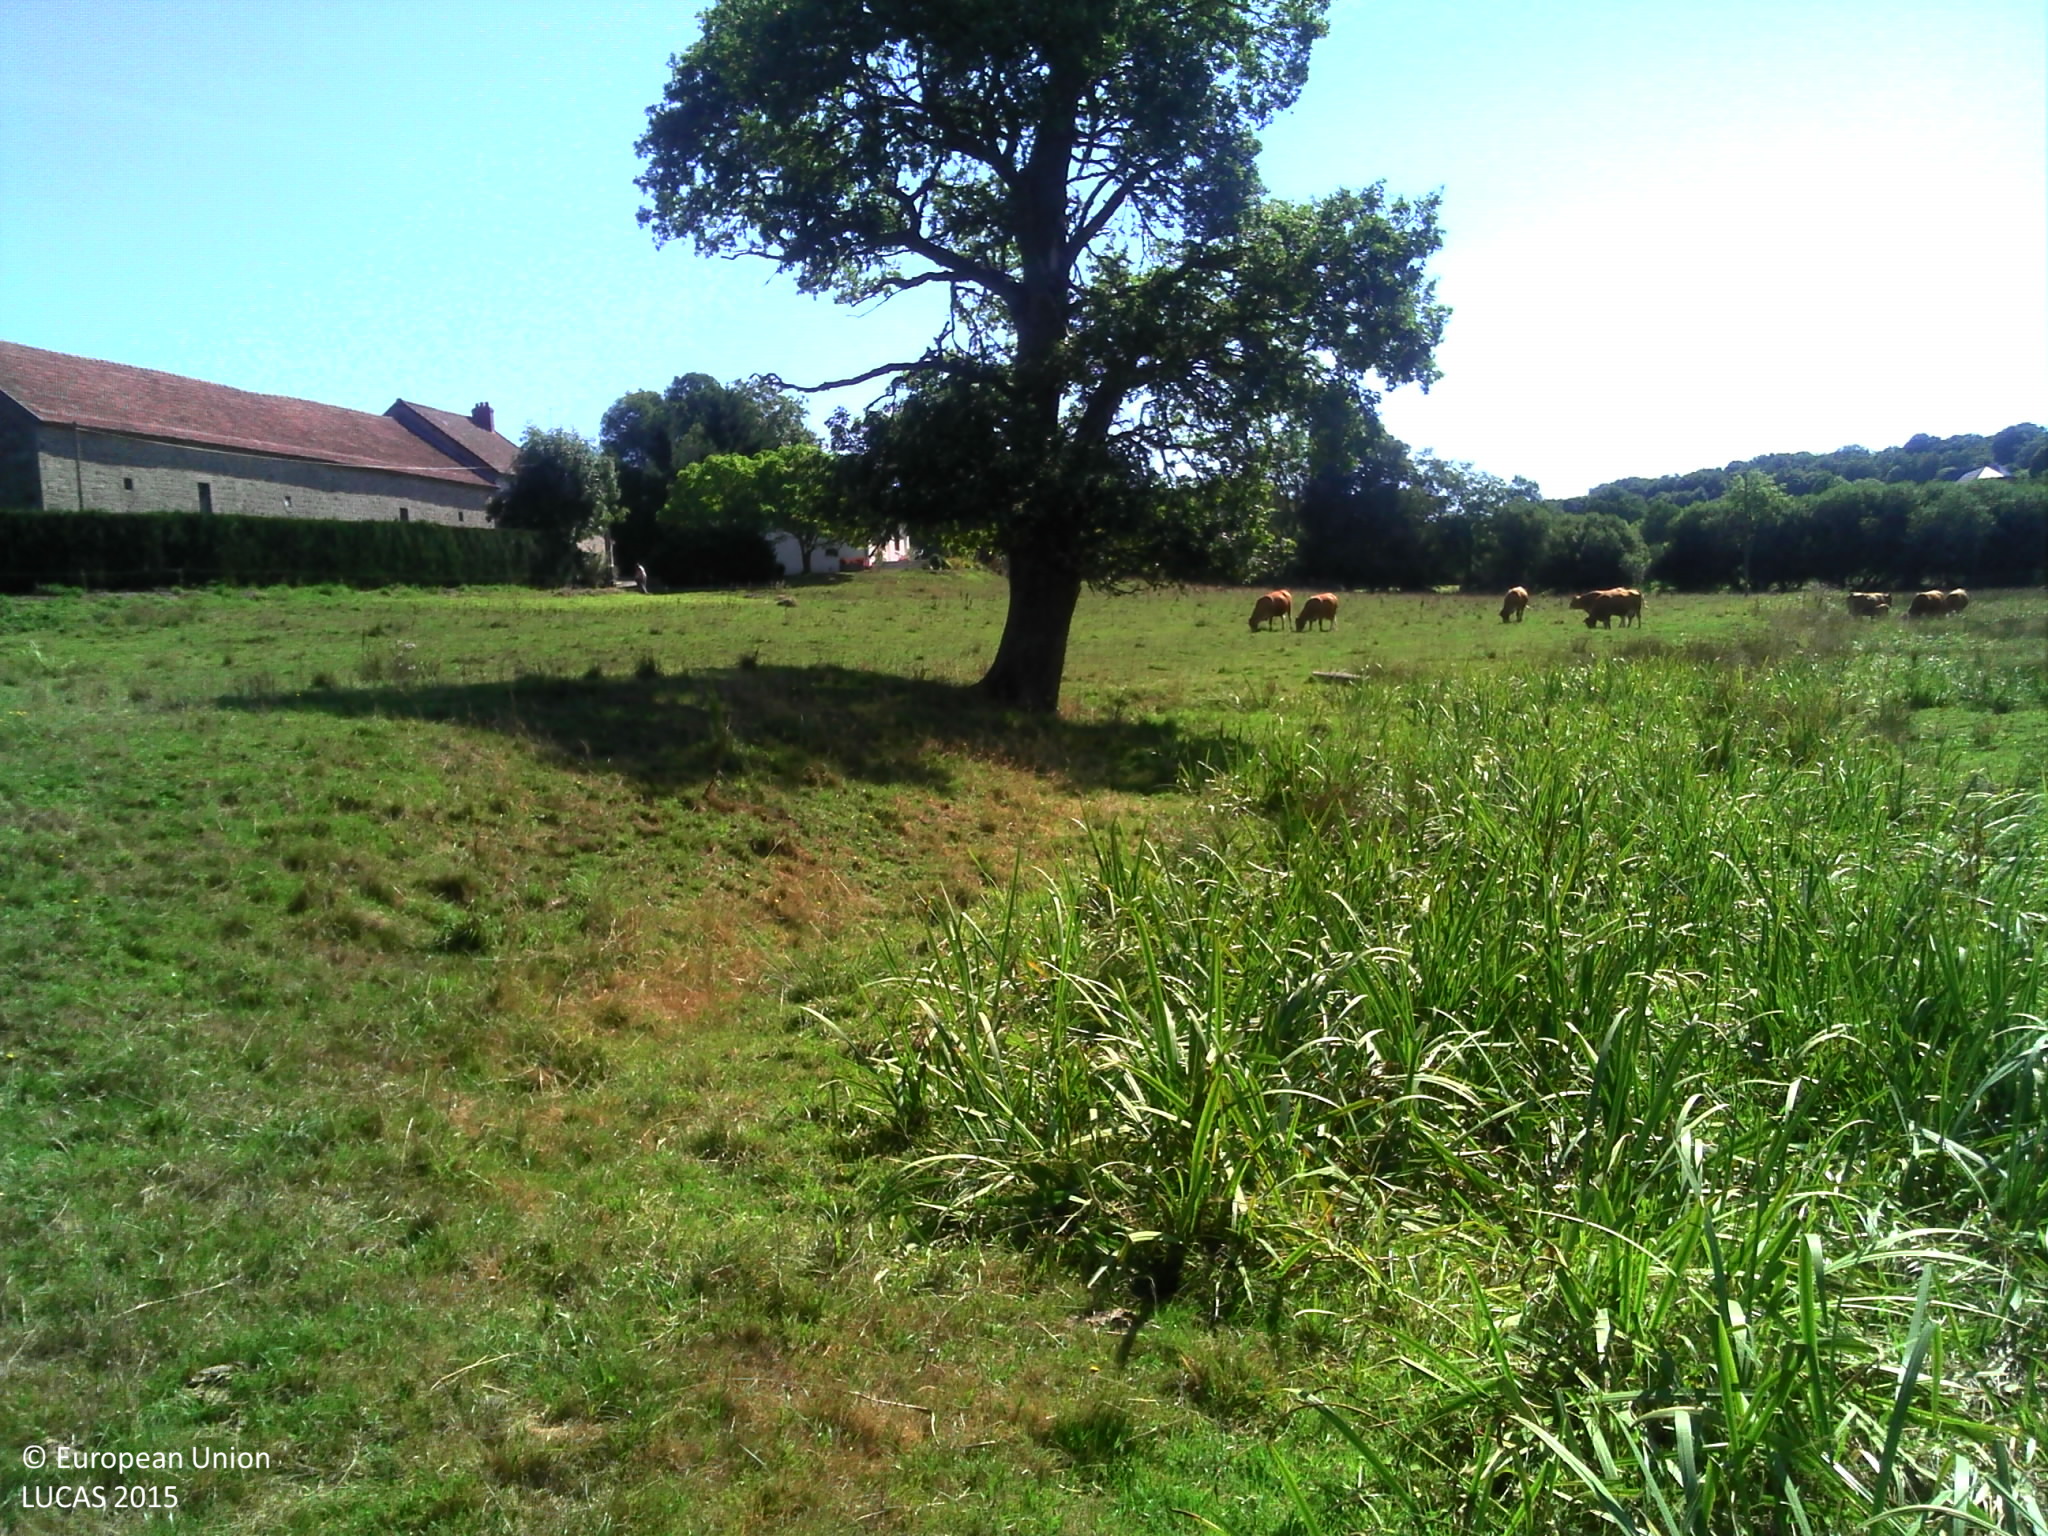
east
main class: Grassland
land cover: Grassland without tree/shrub cover
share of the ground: > 75 %
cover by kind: herbaceous plants 95 %, shrubs 5 %
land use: Agriculture (excluding fallow land and kitchen gardens)
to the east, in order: Grassland without tree/shrub cover; Single bushes/trees; Ditches and canals; Grassland without tree/shrub cover; Fences; Other fresh vegetables; Fences; Grassland without tree/shrub cover; Electric lines; Grassland without tree/shrub cover; Single bushes/trees; Dry stone walls; Abandoned hedges; Fences; Grassland without tree/shrub cover; Dry stone walls; Shruby margins; Grassland without tree/shrub cover
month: August
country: FR
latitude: 45.9143
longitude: 2.3511
